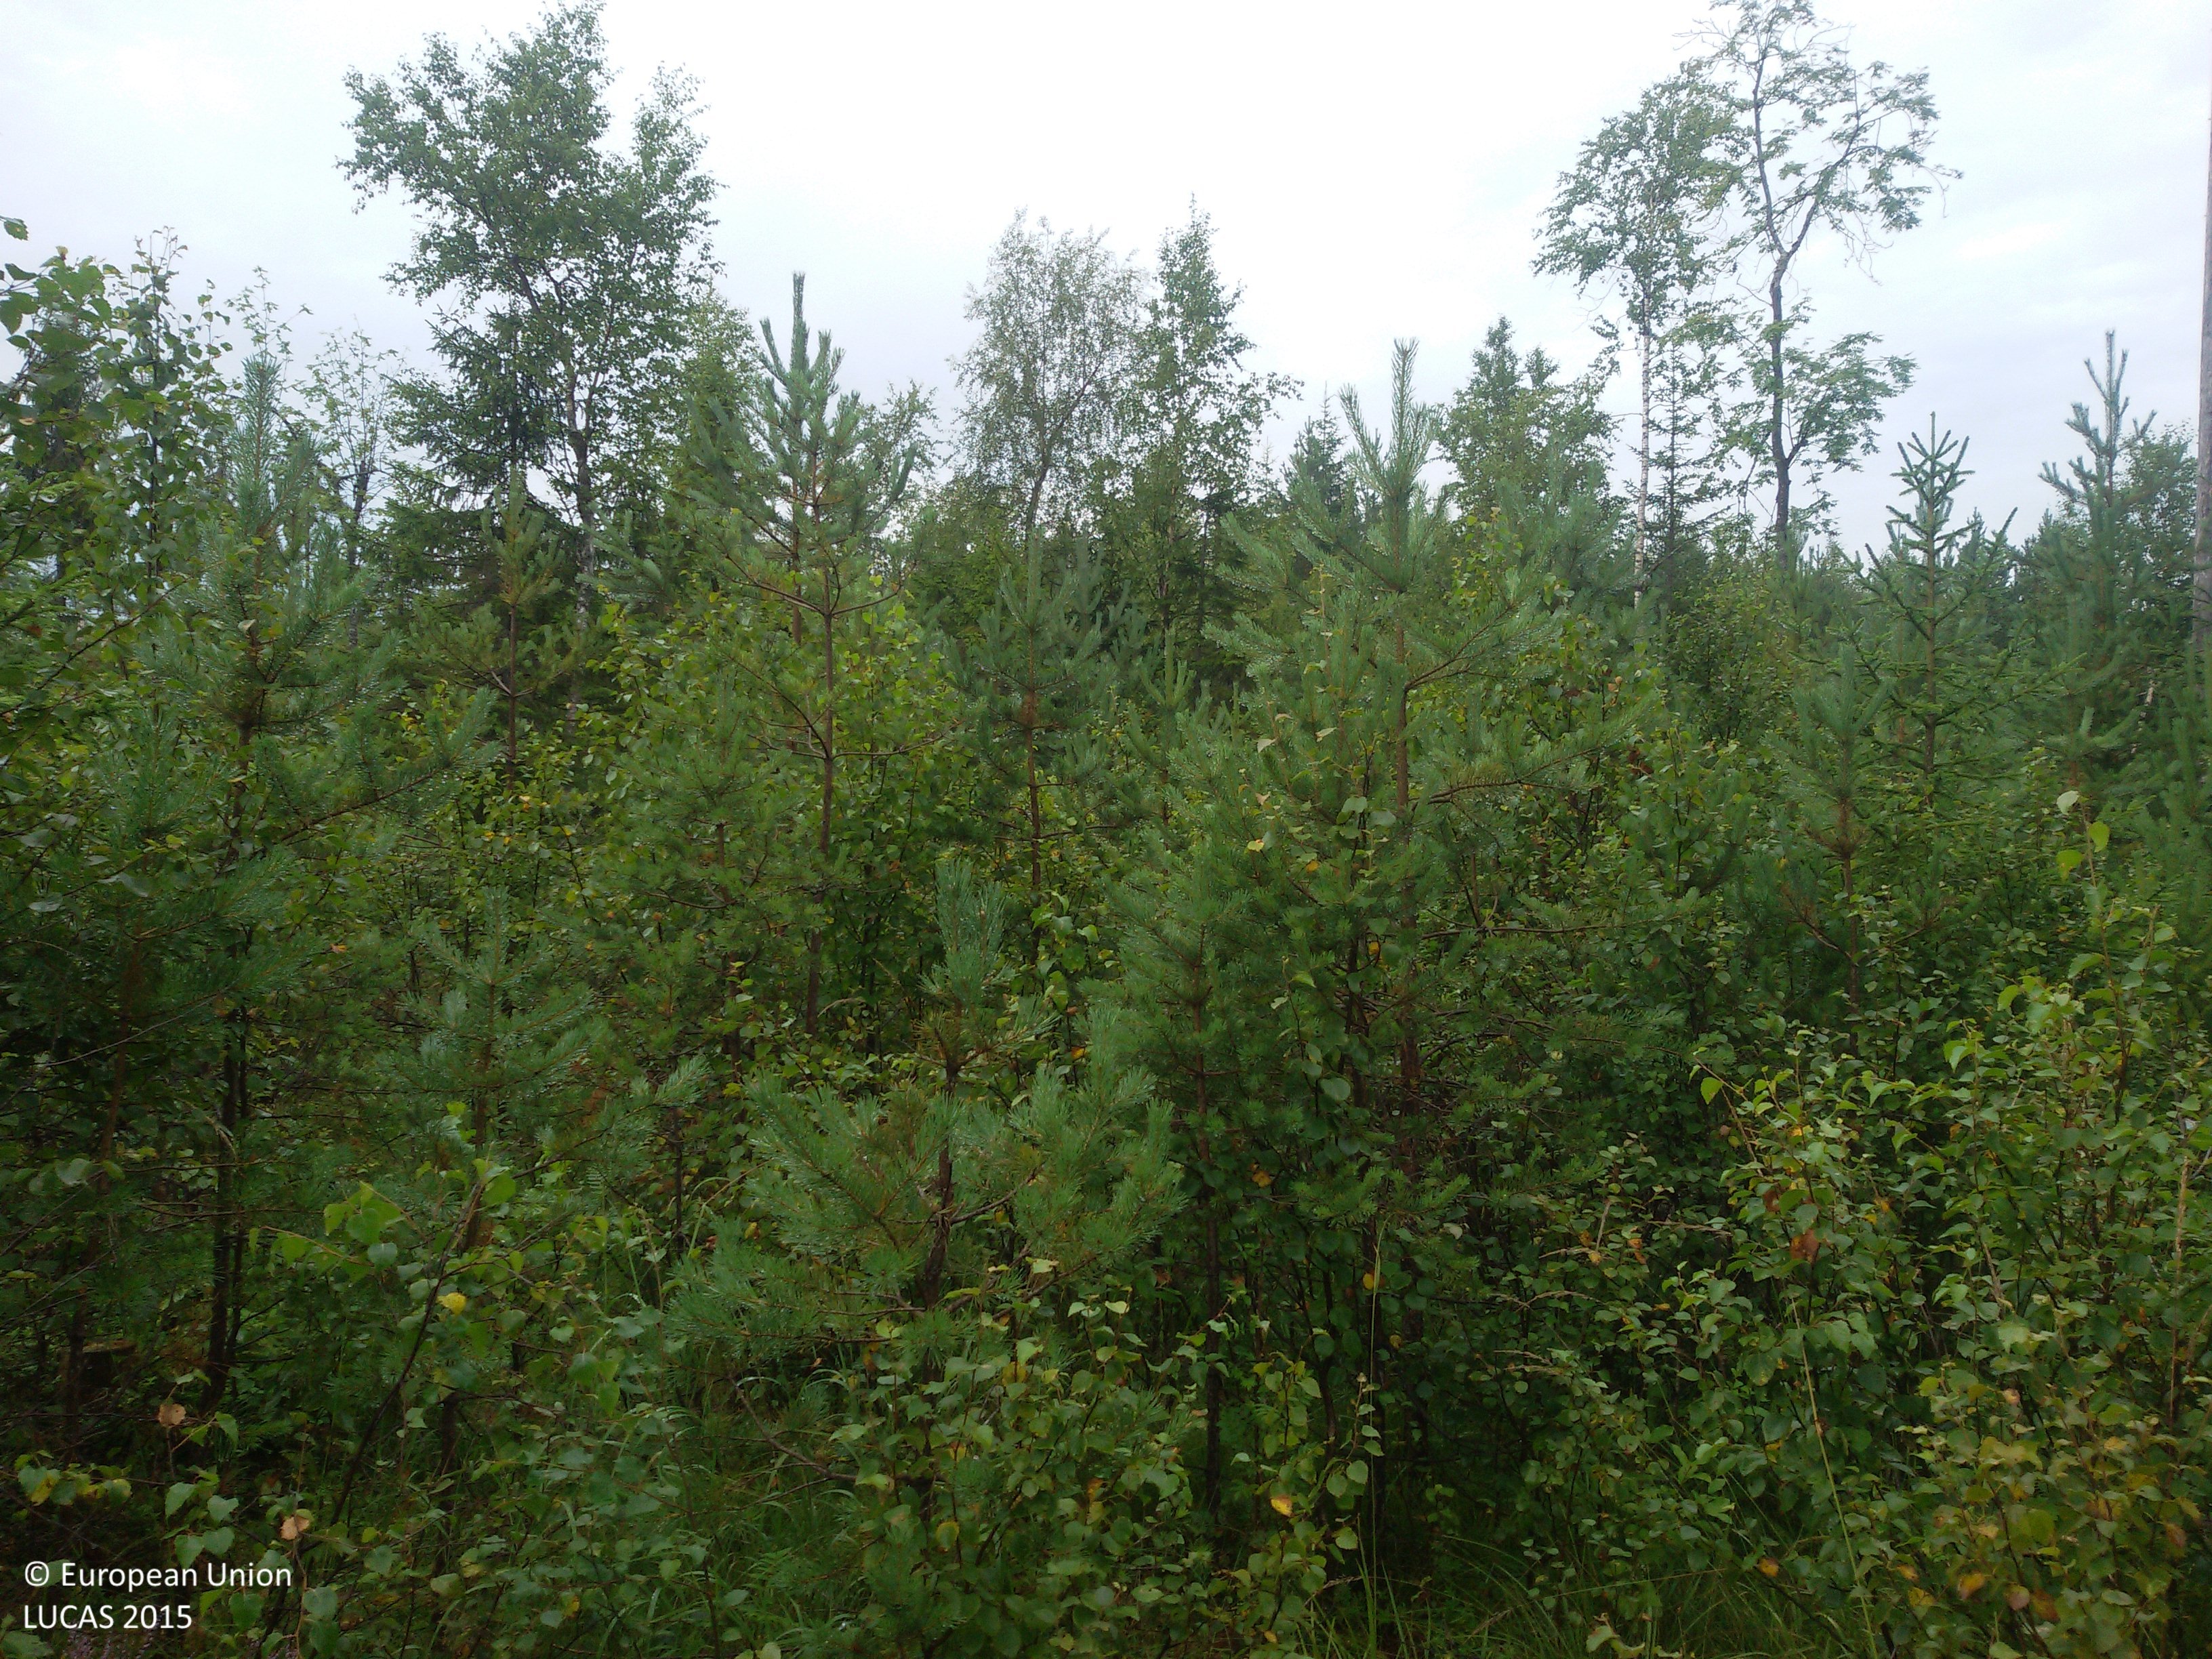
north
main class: Woodland
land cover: Pine dominated mixed woodland
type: boreal forest
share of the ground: > 75 %
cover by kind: coniferous forest trees 40 %, broadleaved forest trees 40 %, herbaceous plants 20 %
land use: Forestry
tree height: < 5 m
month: August
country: SE
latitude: 60.7666
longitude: 16.6142
